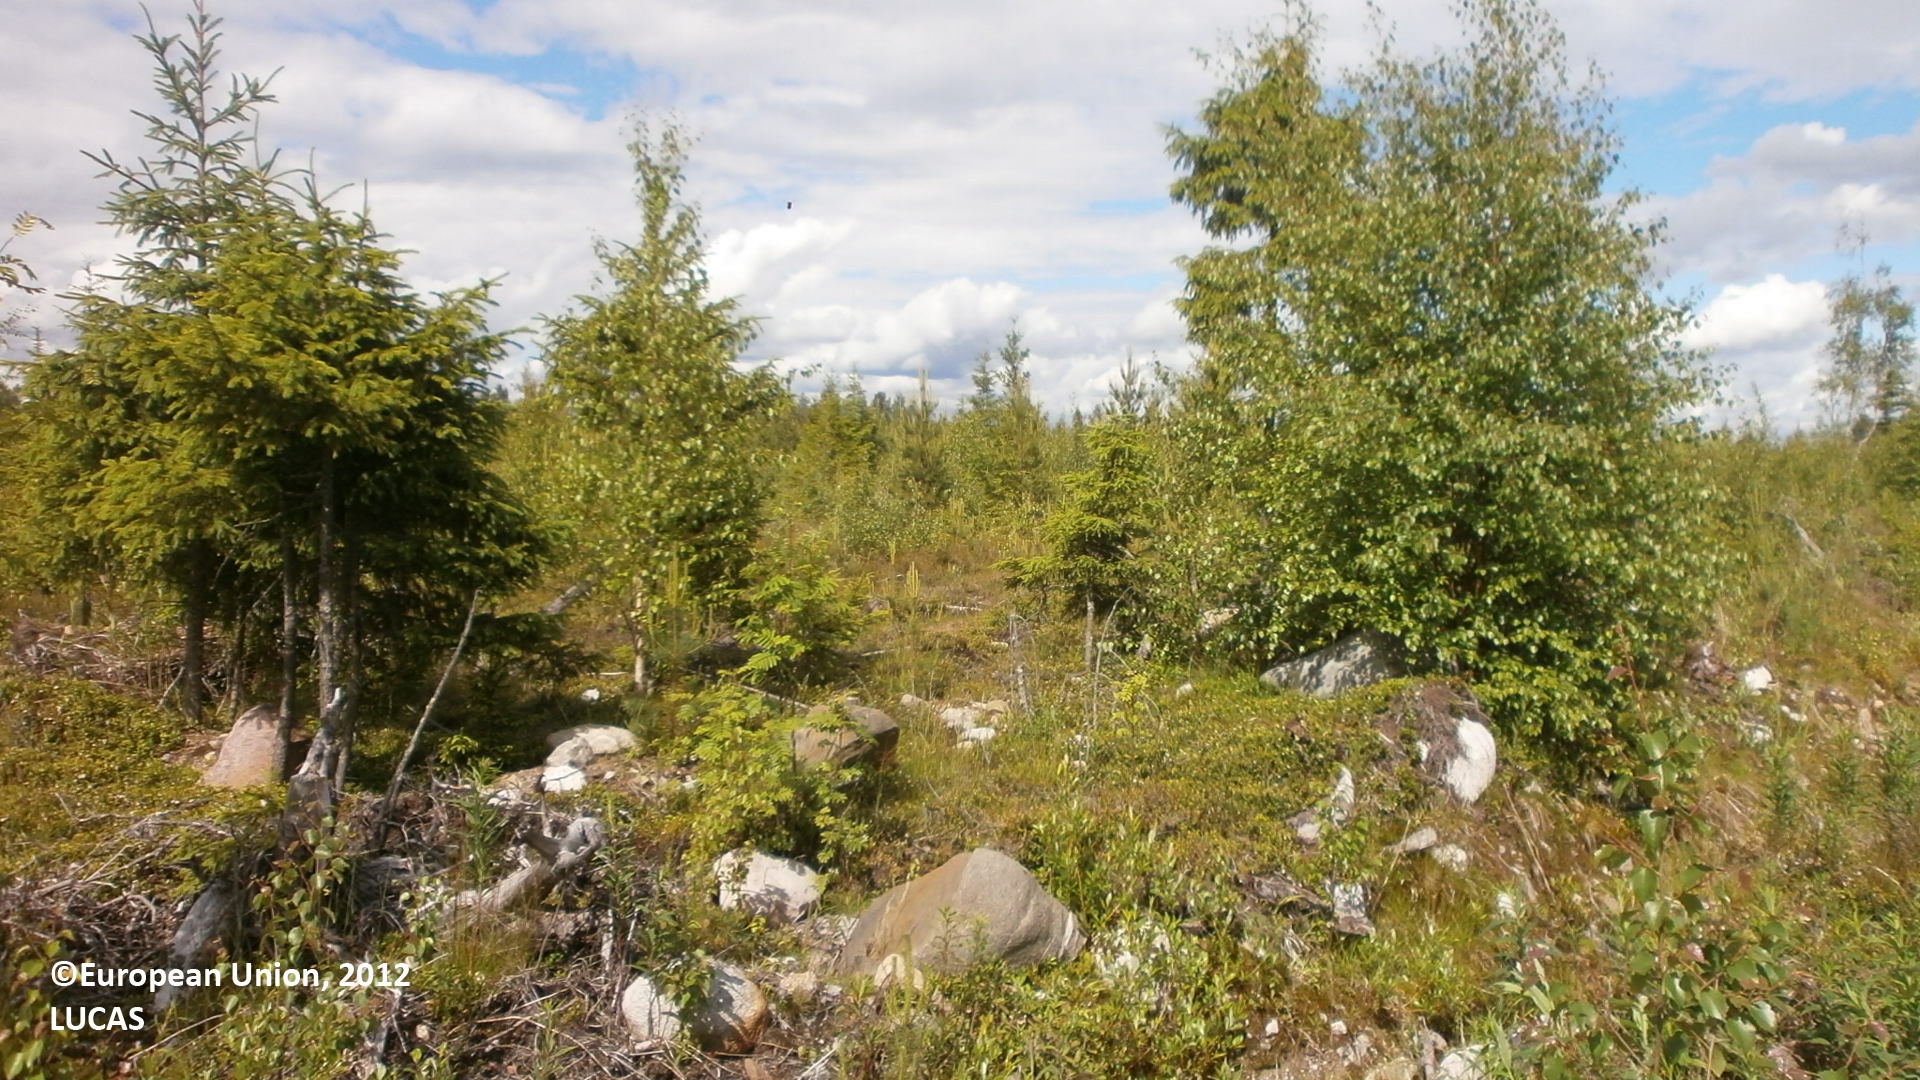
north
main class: Woodland
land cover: Broadleaved woodland
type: boreal forest
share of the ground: 10 - 25 %
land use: Forestry
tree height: < 5 m
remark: Clear cut
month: June
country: FI
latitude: 64.2907
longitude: 24.9774
